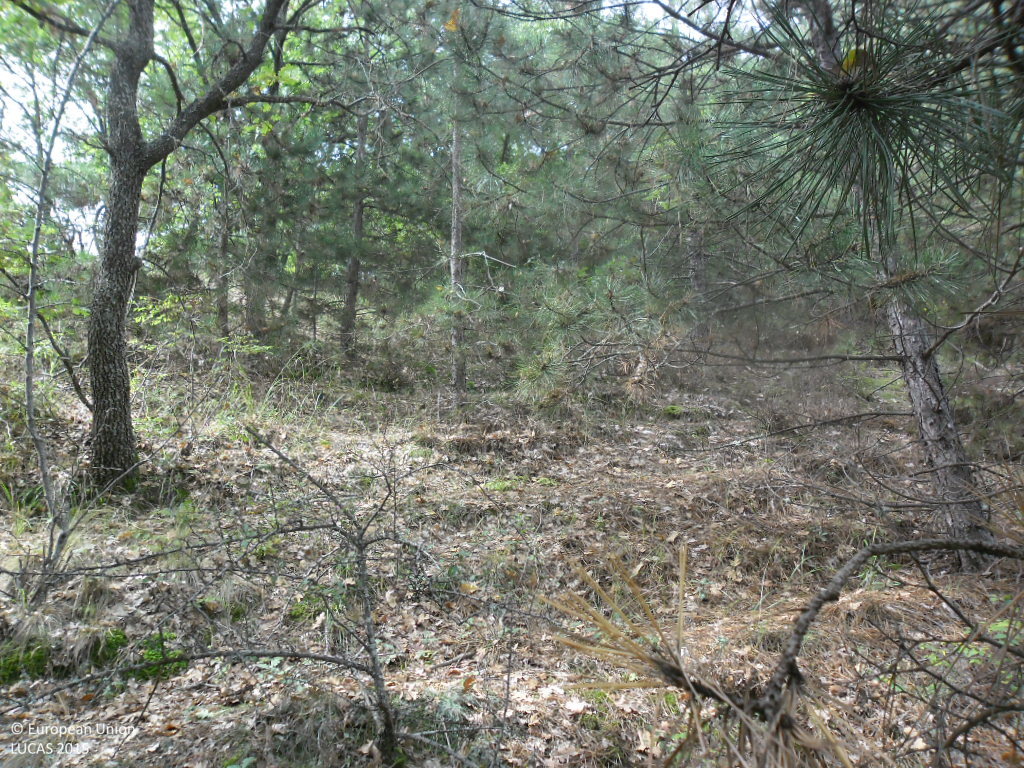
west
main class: Woodland
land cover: Other mixed woodland
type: hemiboreal forest and nemoral coniferous forest and mixed broadleaved-coniferous forest
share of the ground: > 75 %
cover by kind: coniferous forest trees 75 %, broadleaved forest trees 25 %
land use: Forestry
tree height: > 5 m
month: September
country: BG
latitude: 41.4014
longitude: 23.0671
